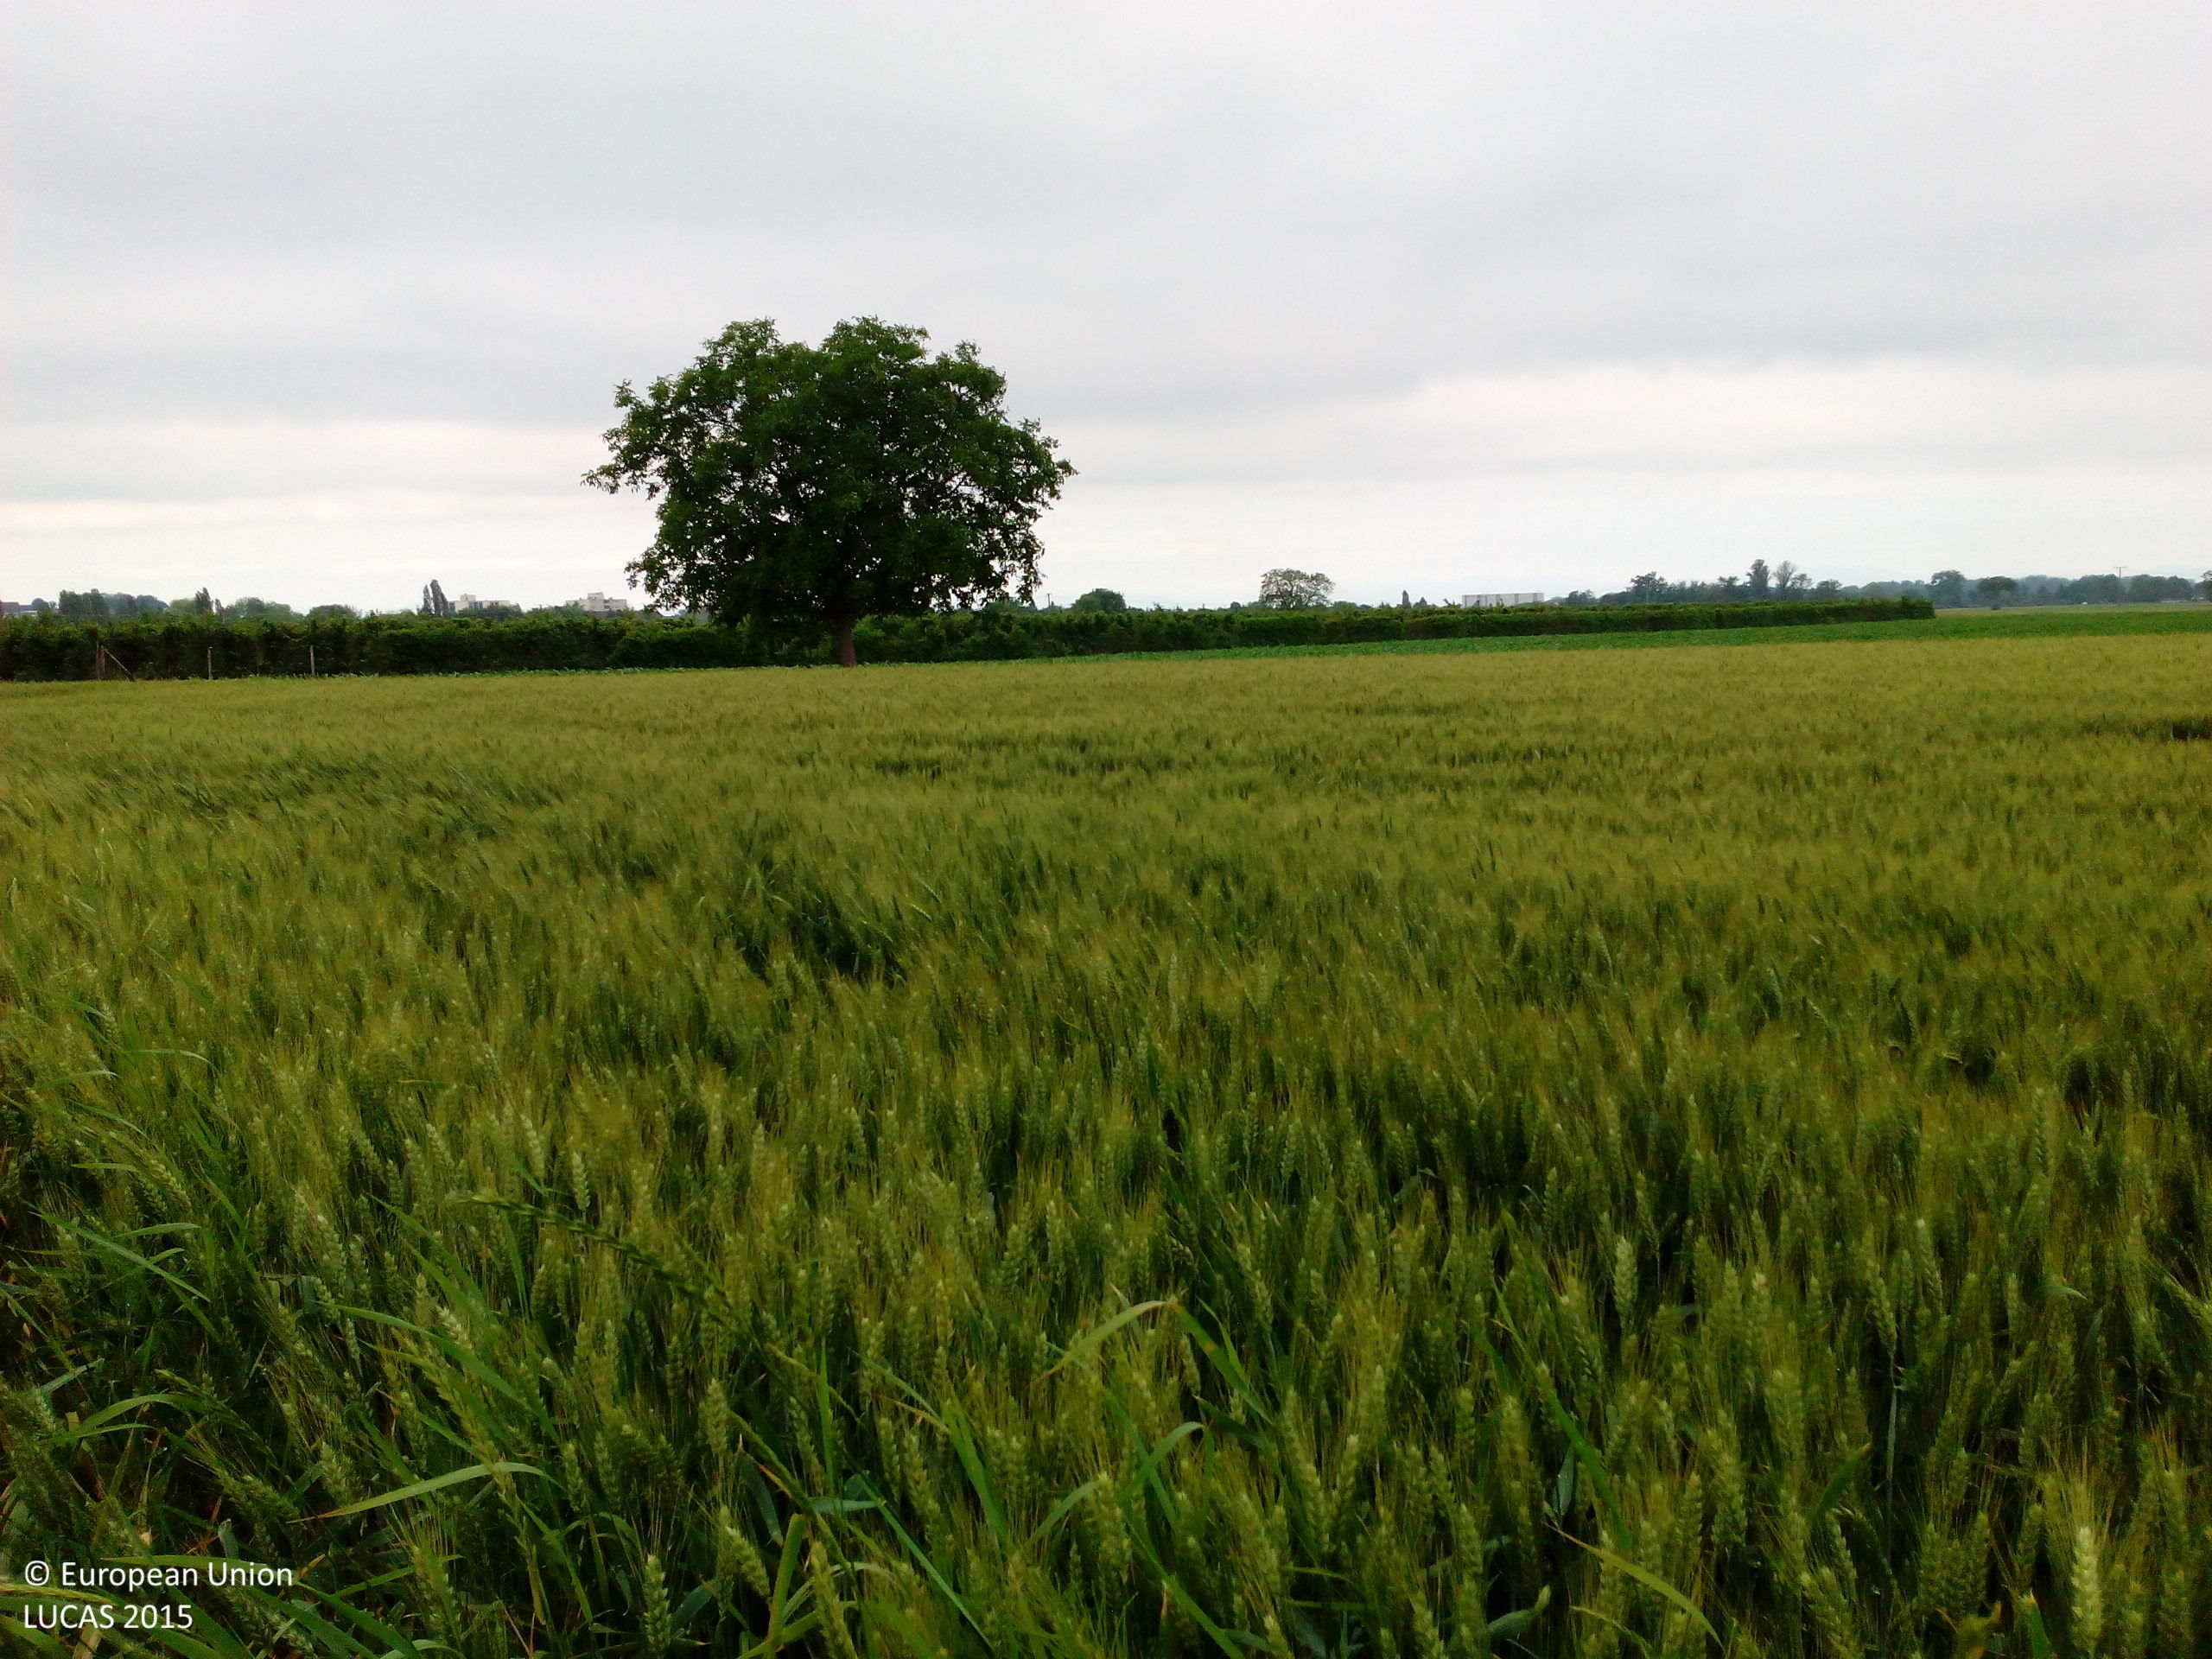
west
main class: Cropland
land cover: Durum wheat
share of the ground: > 75 %
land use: Agriculture (excluding fallow land and kitchen gardens)
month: June
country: DE
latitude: 48.0354
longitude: 7.6005
